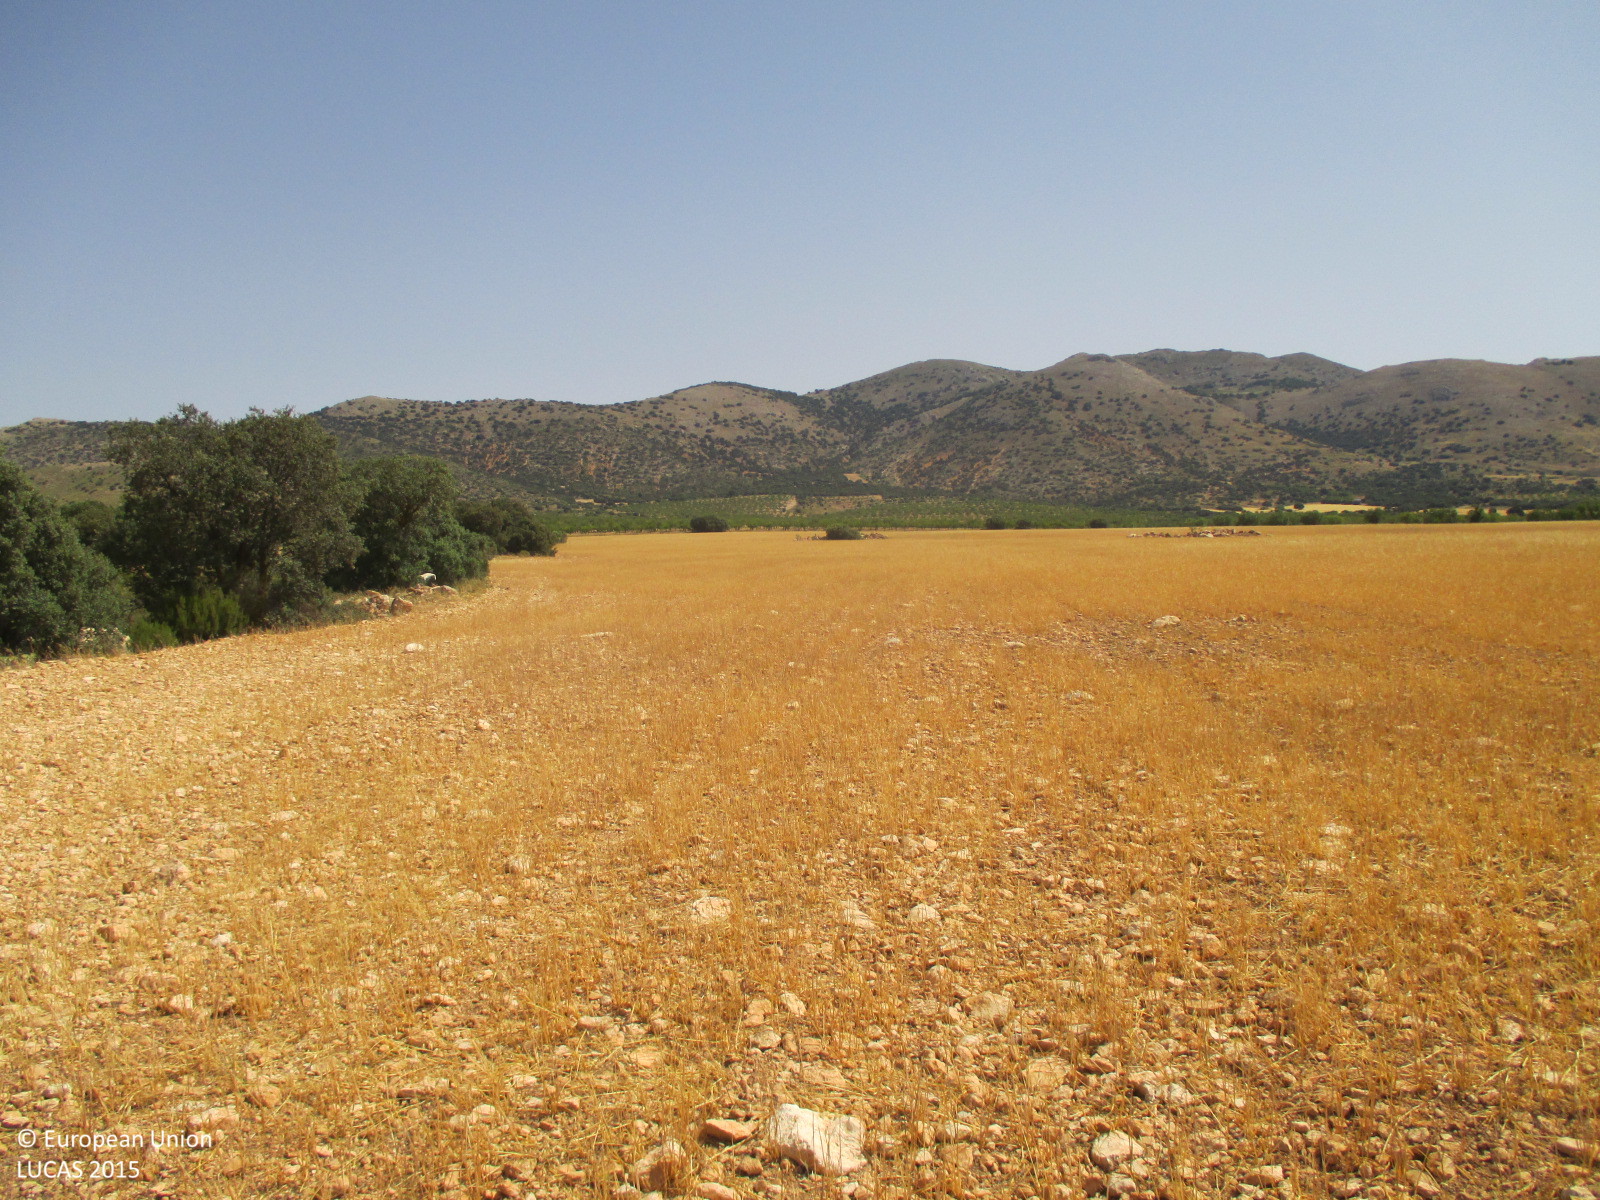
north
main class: Cropland
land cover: Oats
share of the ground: < 10 %
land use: Agriculture (excluding fallow land and kitchen gardens)
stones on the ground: < 10 %
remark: Harvested field
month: June
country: ES
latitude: 37.6059
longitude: -2.4352
